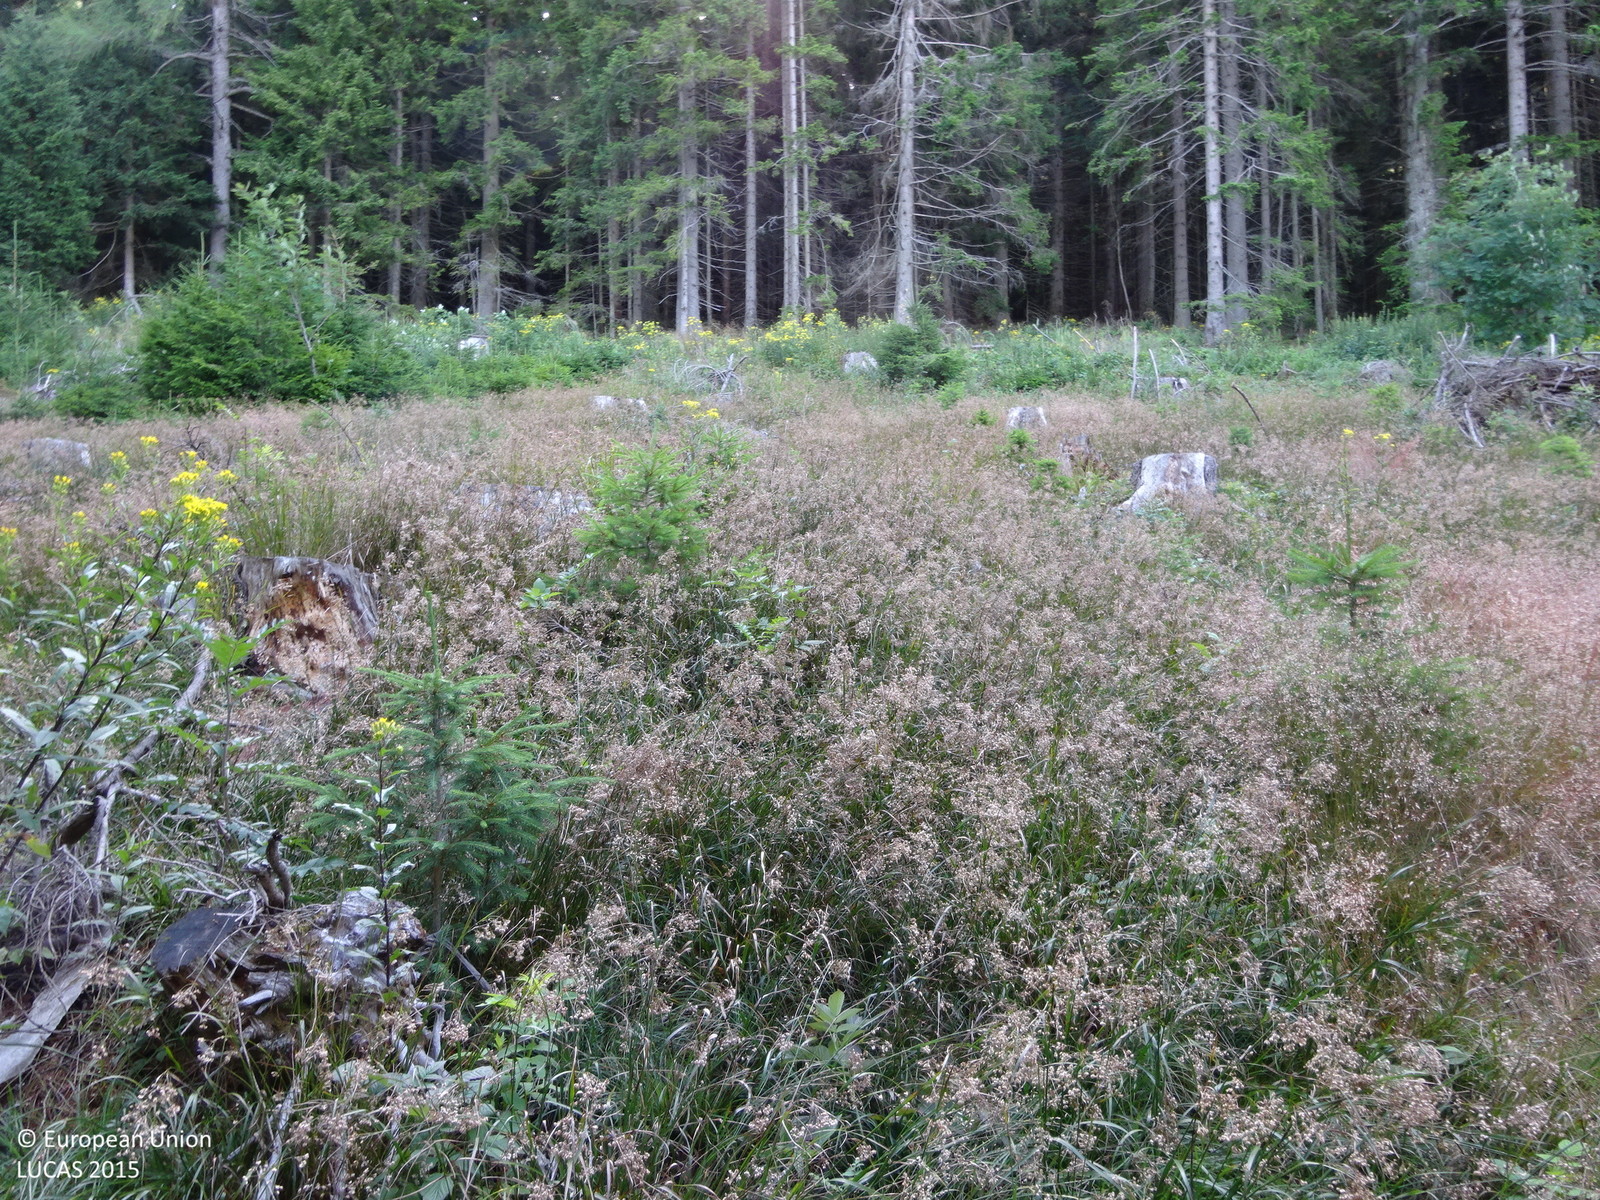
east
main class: Grassland
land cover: Grassland with sparse tree/shrub cover
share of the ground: > 75 %
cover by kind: herbaceous plants 95 %, coniferous forest trees 5 %
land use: Forestry
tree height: < 5 m
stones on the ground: < 10 %
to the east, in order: Grassland with sparse tree/shrub cover; Tracks; Spruce dominated coniferous woodland; Tracks; Spruce dominated coniferous woodland
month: August
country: AT
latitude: 47.3470
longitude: 15.4939
